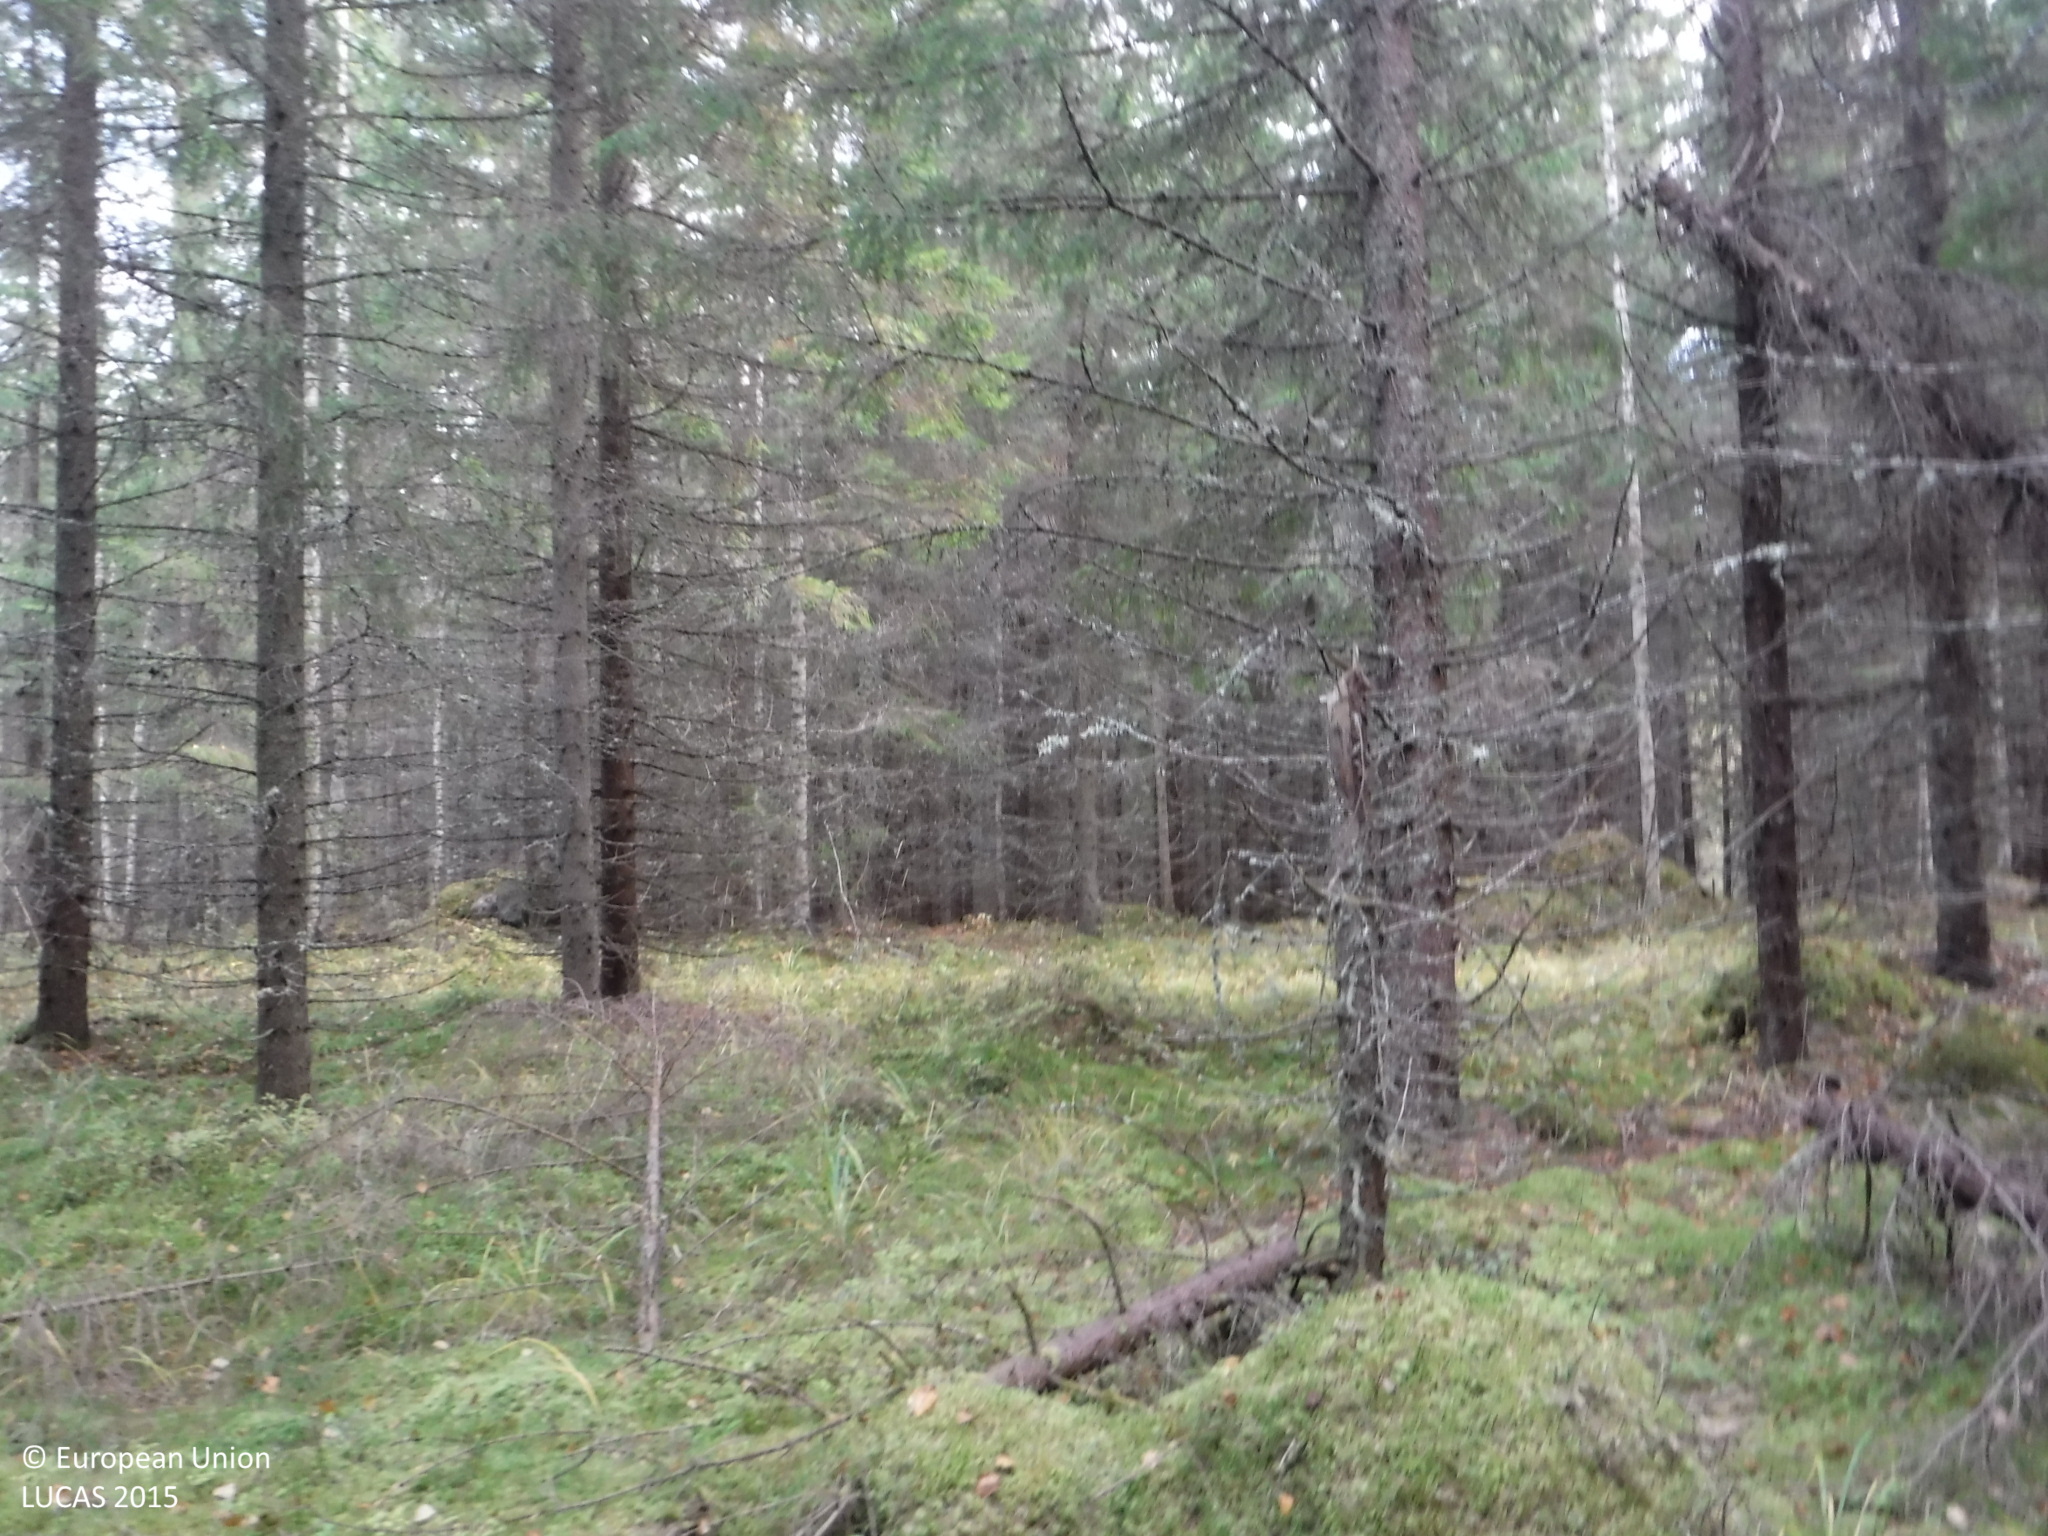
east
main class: Woodland
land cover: Spruce dominated coniferous woodland
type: boreal forest
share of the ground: > 75 %
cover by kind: coniferous forest trees 75 %, lichens and mosses 20 %, shrubs 5 %
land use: Forestry
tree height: > 5 m
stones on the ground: 25 - 50 %
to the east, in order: Spruce dominated coniferous woodland; Spruce dominated mixed woodland; Spruce dominated coniferous woodland; Other mixed woodland; Spruce dominated coniferous woodland; Groves; Tracks; Groves; Ditches and canals; Spruce dominated mixed woodland; Ditches and canals; Groves; Tracks; Spruce dominated mixed woodland; Broadleaved woodland
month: October
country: FI
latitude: 61.9758
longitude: 25.9441
